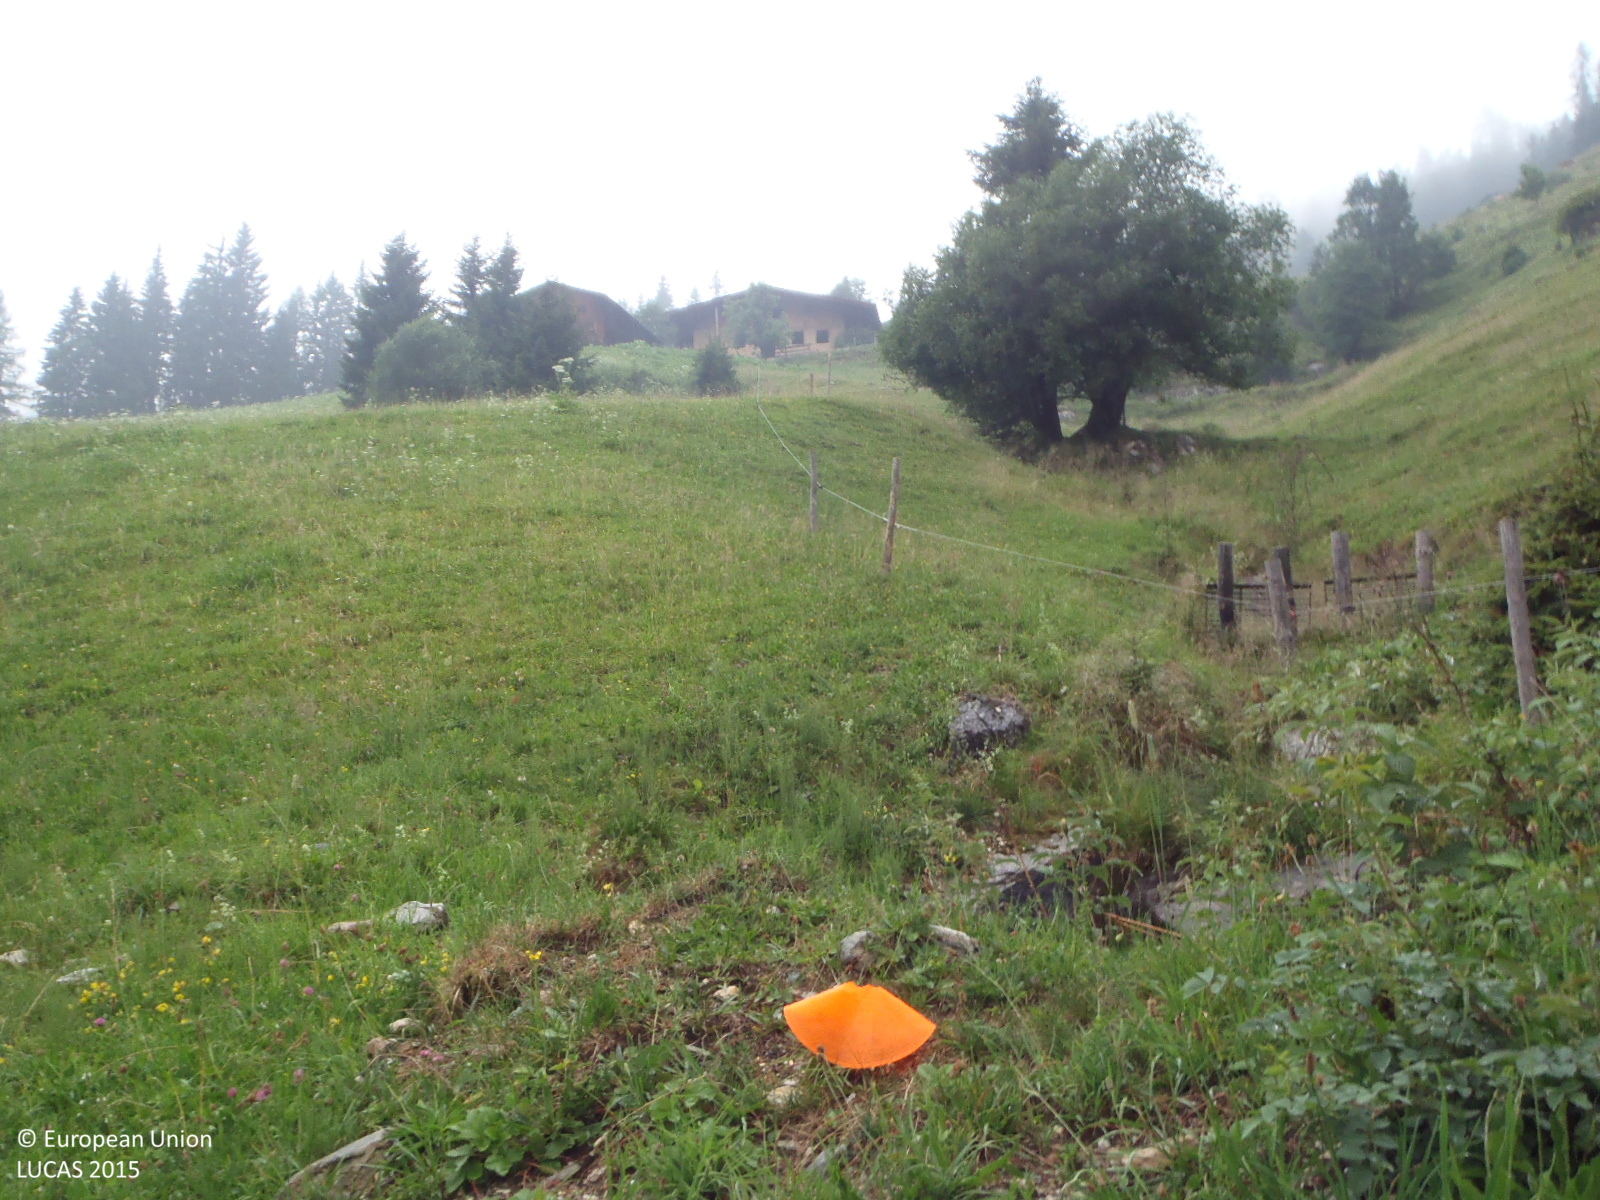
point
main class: Grassland
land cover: Grassland without tree/shrub cover
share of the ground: > 75 %
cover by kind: herbaceous plants 100 %
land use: Agriculture (excluding fallow land and kitchen gardens)
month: July
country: AT
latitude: 47.2158
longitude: 11.9657
